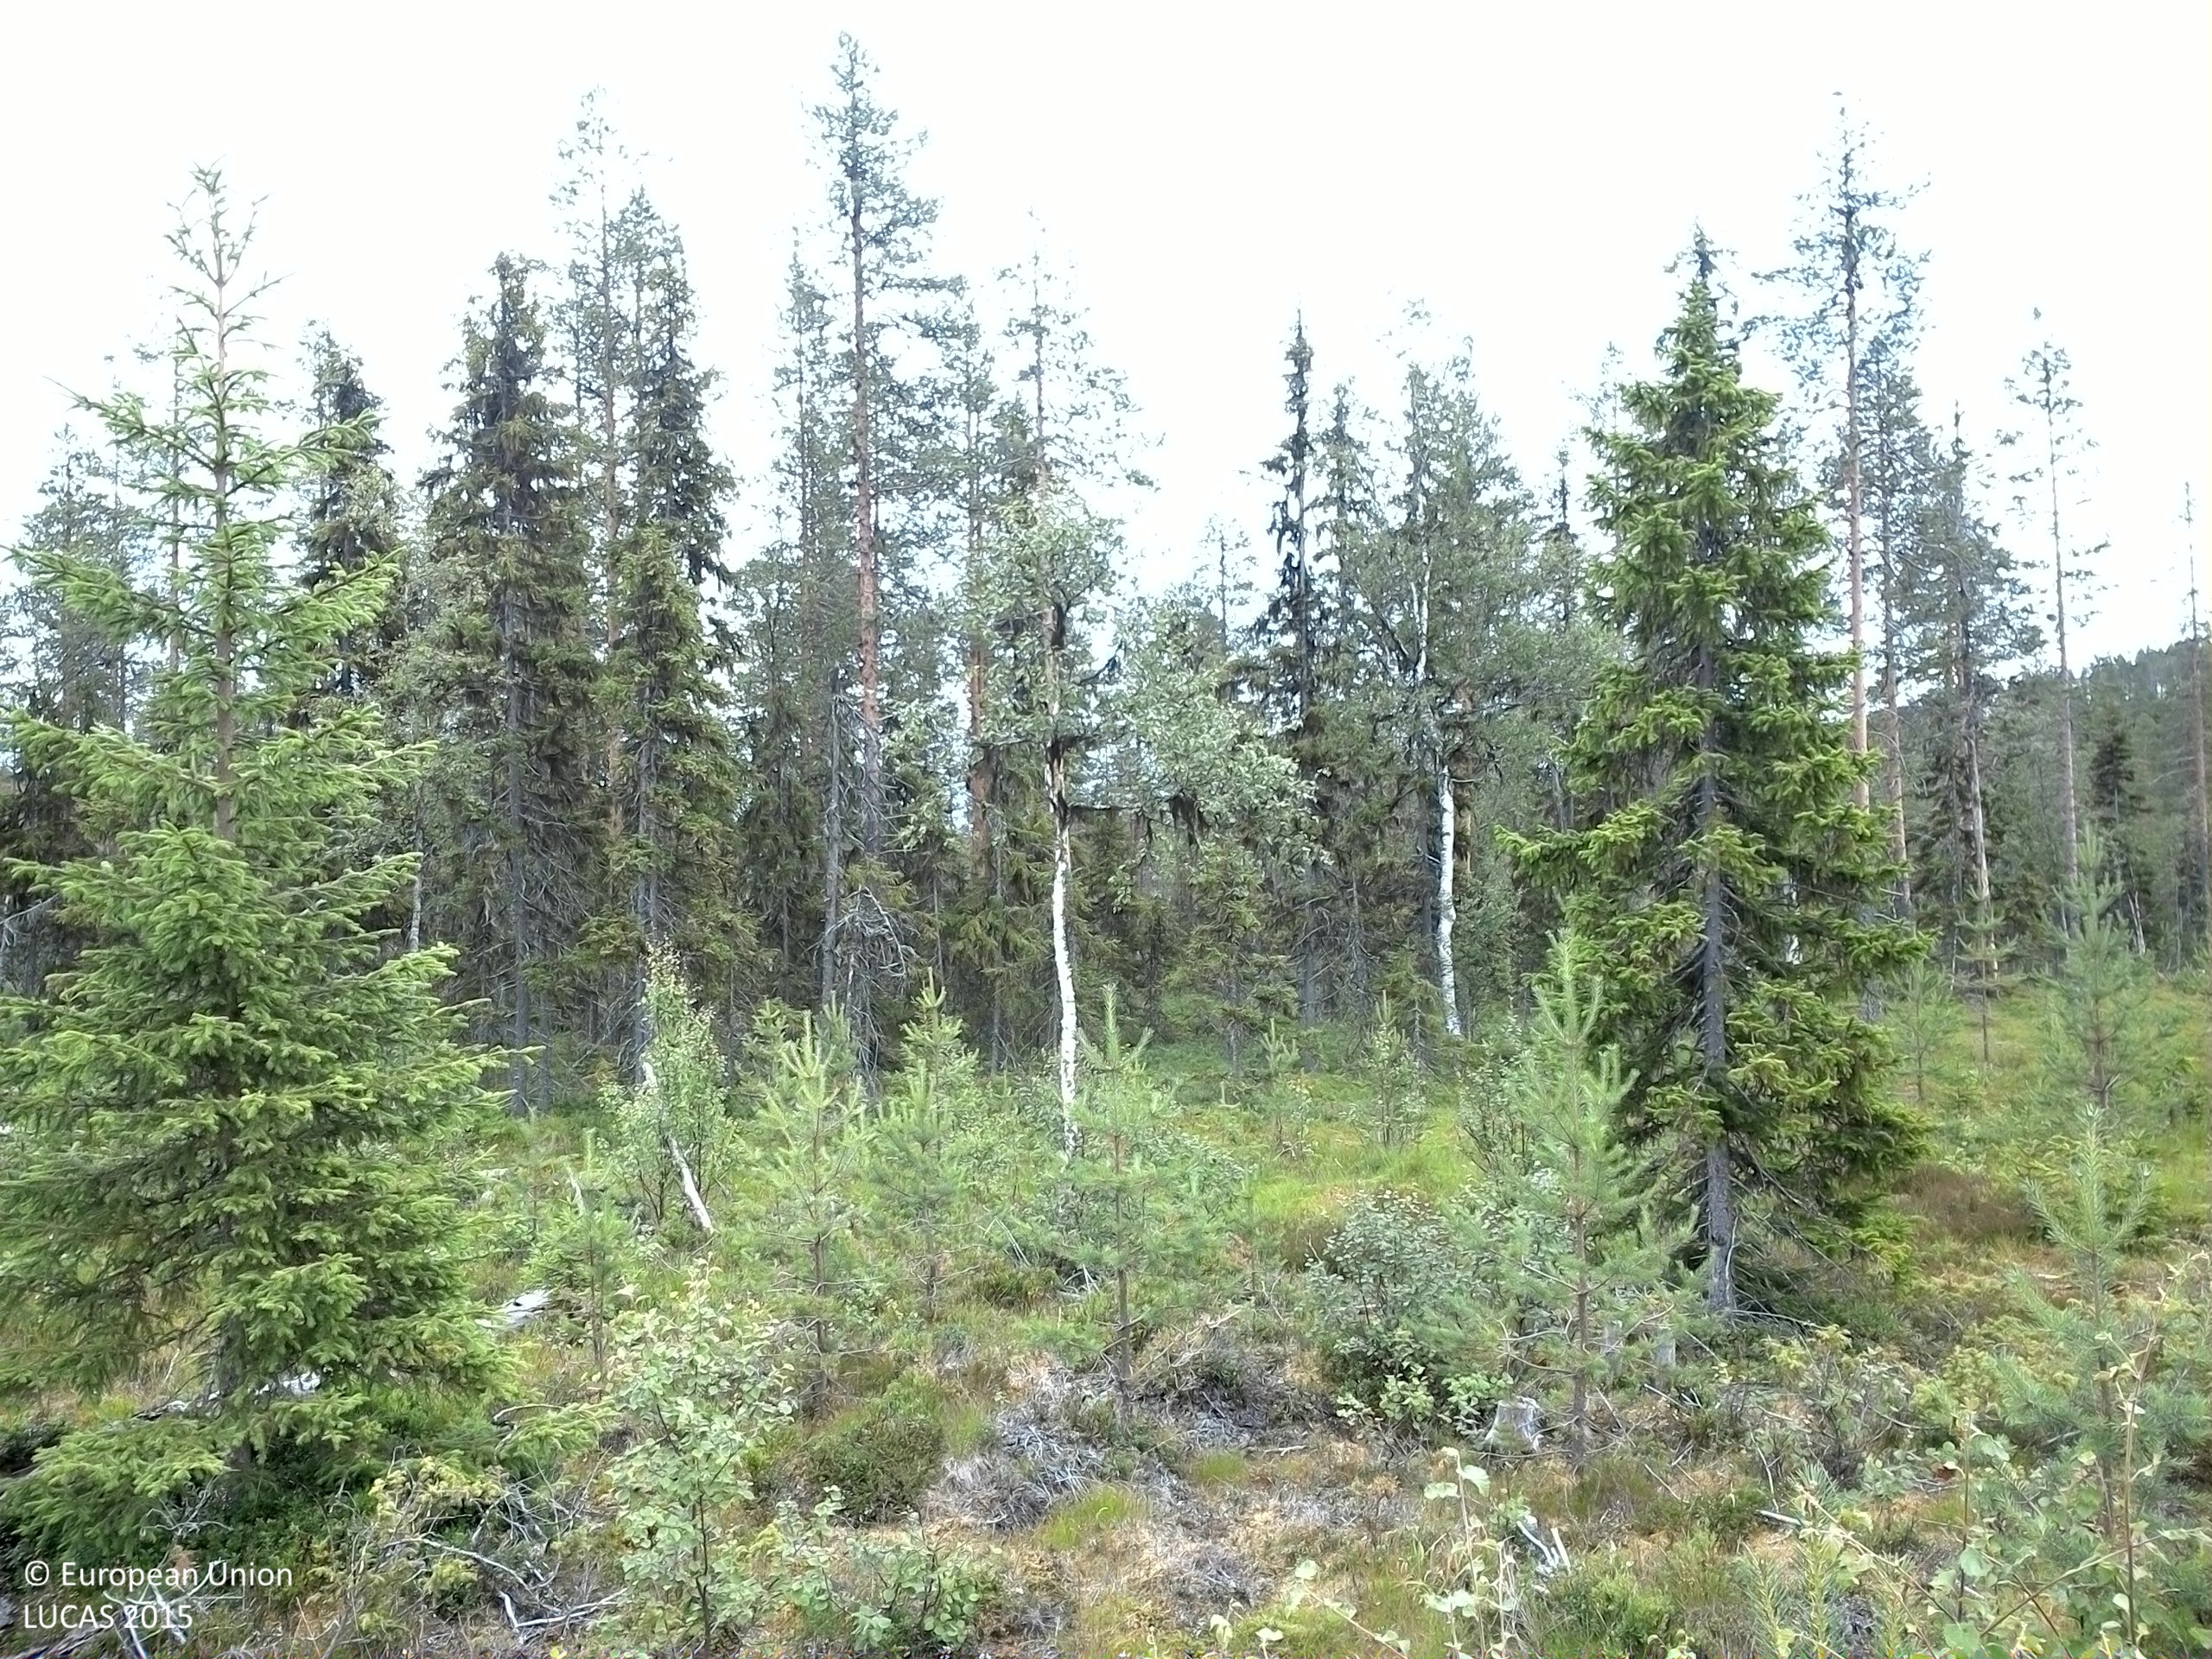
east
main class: Woodland
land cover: Pine dominated mixed woodland
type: boreal forest
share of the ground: 25 - 50 %
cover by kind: shrubs 45 %, coniferous forest trees 20 %, herbaceous plants 15 %, broadleaved forest trees 10 %, lichens and mosses 10 %
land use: Forestry
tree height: < 5 m
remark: Clear cut
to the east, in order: Pine dominated mixed woodland; Pine dominated coniferous woodland
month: August
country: SE
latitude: 63.7015
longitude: 18.0859
